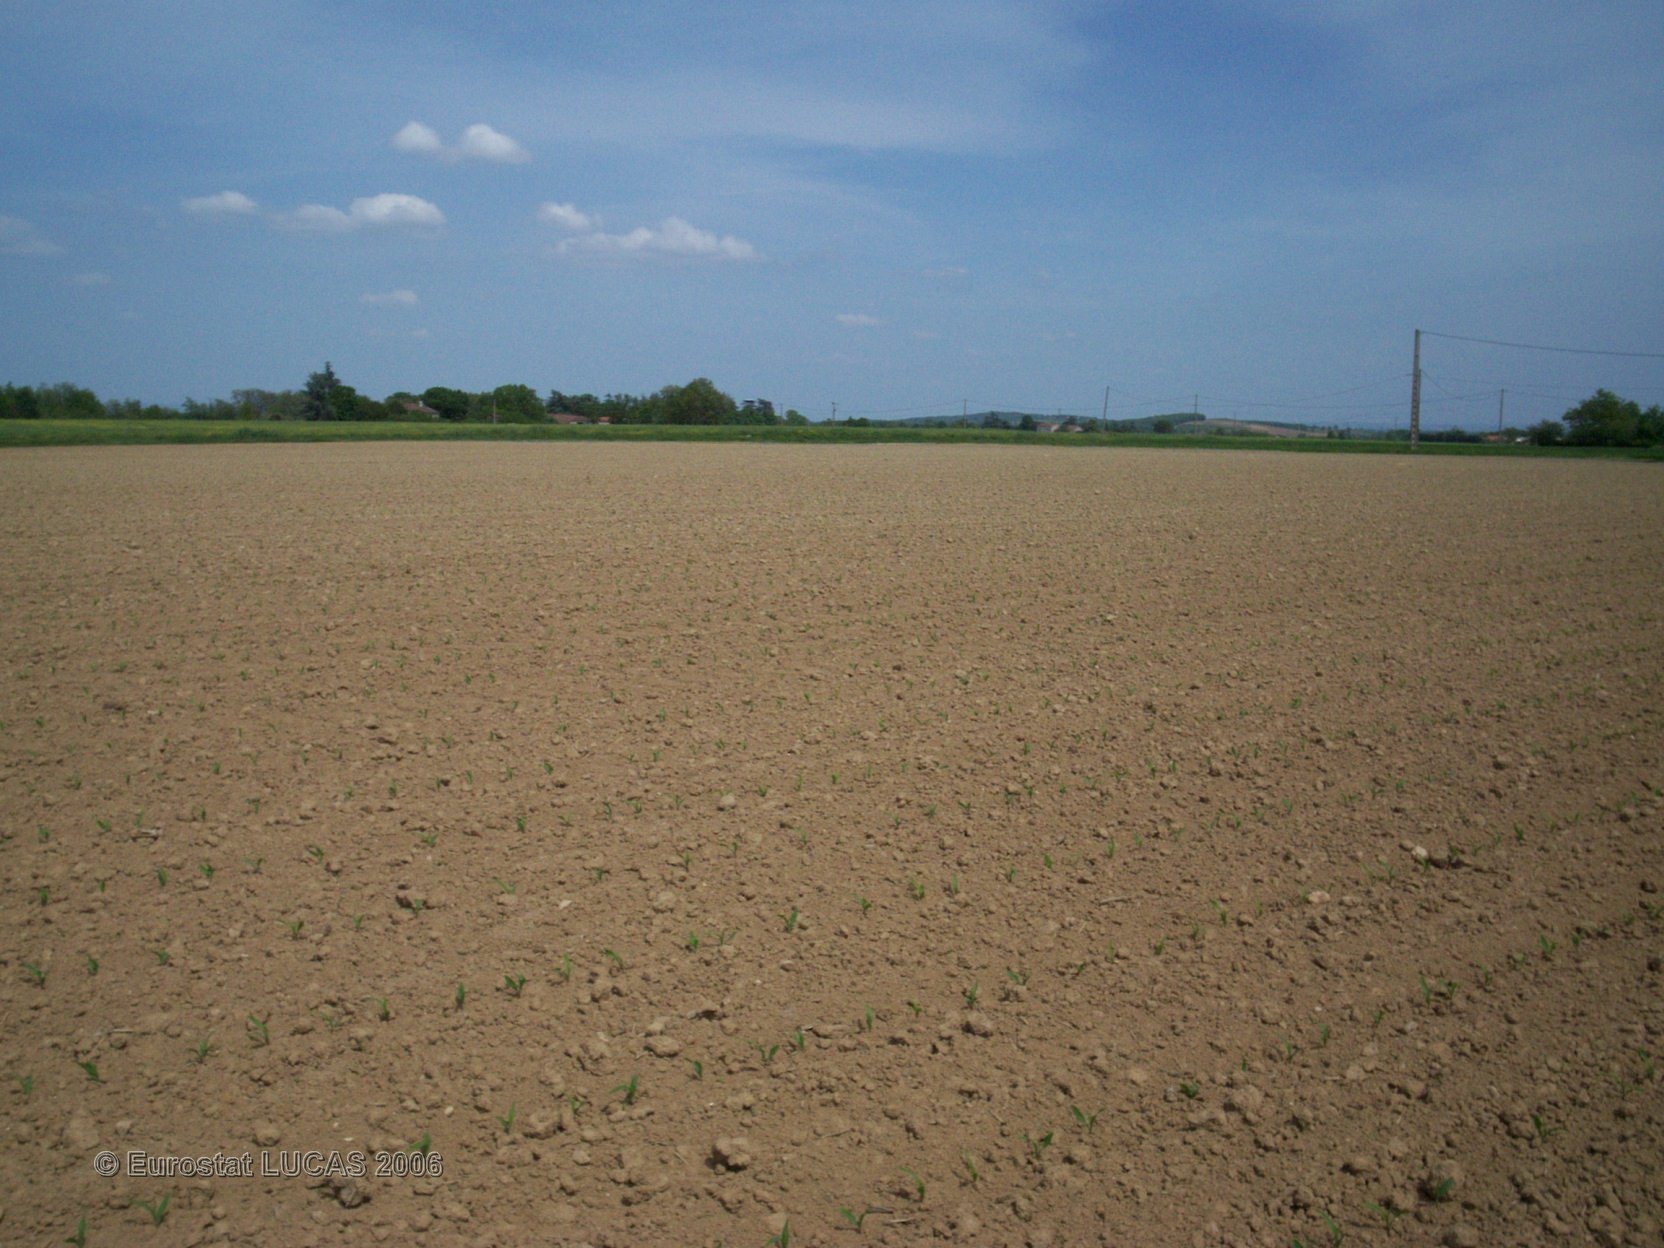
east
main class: Cropland
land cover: Maize
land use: Agriculture (excluding fallow land and kitchen gardens)
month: May
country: FR
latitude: 43.8784
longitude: 2.0011
